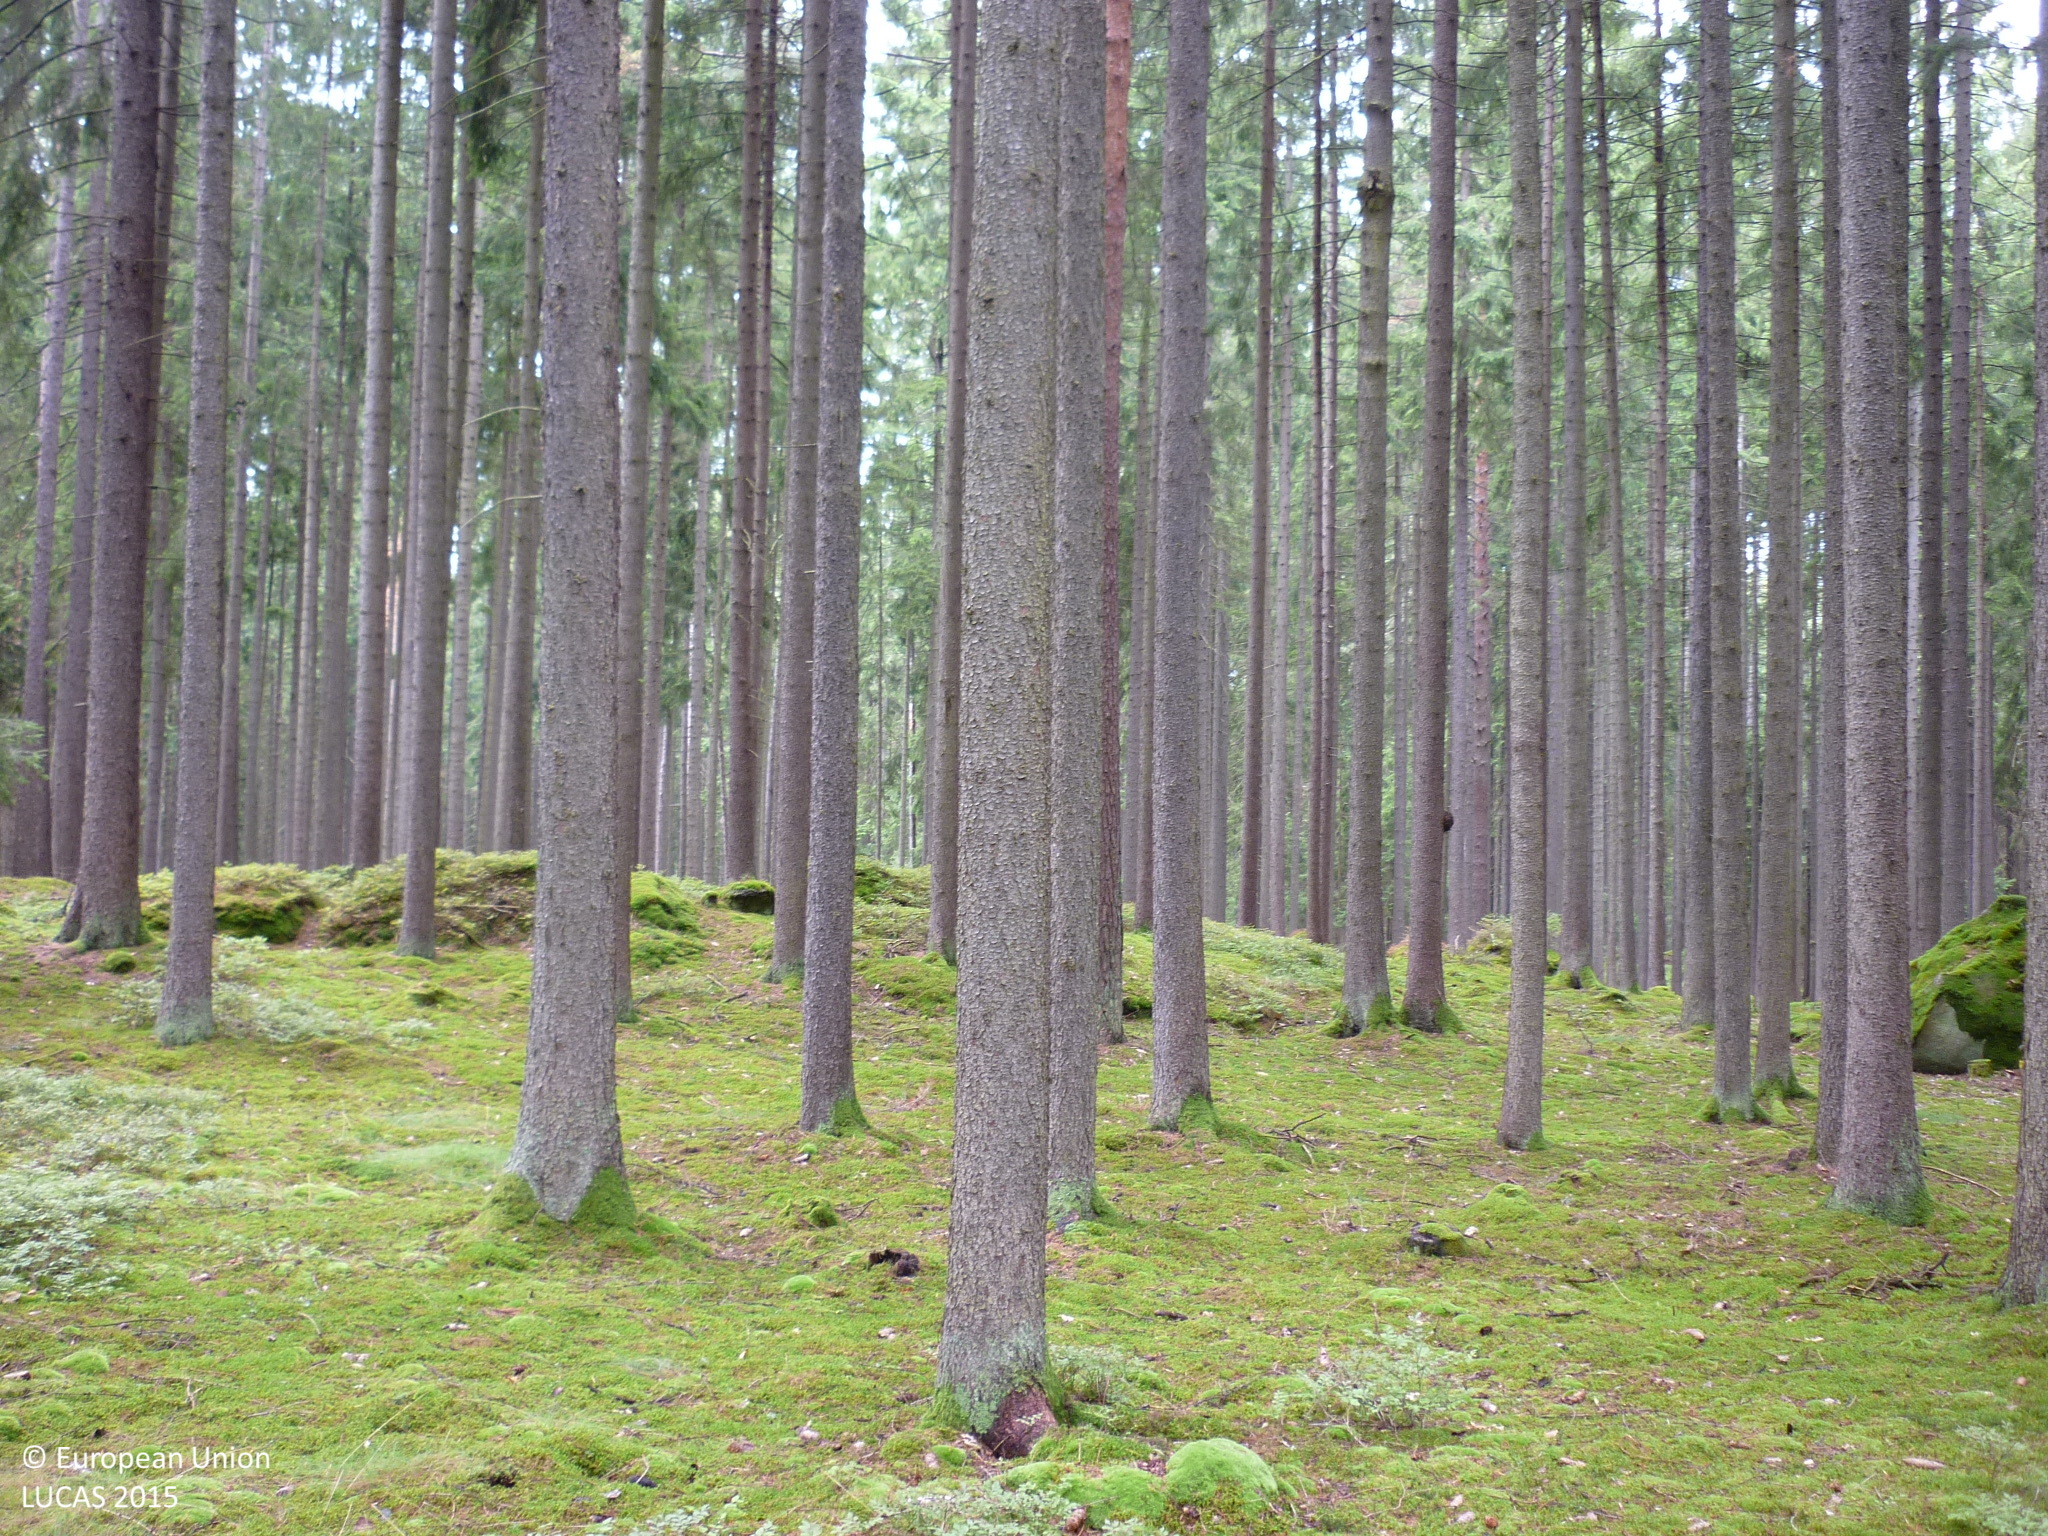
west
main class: Woodland
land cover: Spruce dominated coniferous woodland
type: hemiboreal forest and nemoral coniferous forest and mixed broadleaved-coniferous forest
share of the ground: > 75 %
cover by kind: coniferous forest trees 90 %, shrubs 5 %, lichens and mosses 5 %
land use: Forestry
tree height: > 5 m
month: September
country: AT
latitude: 48.7952
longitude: 14.9979
